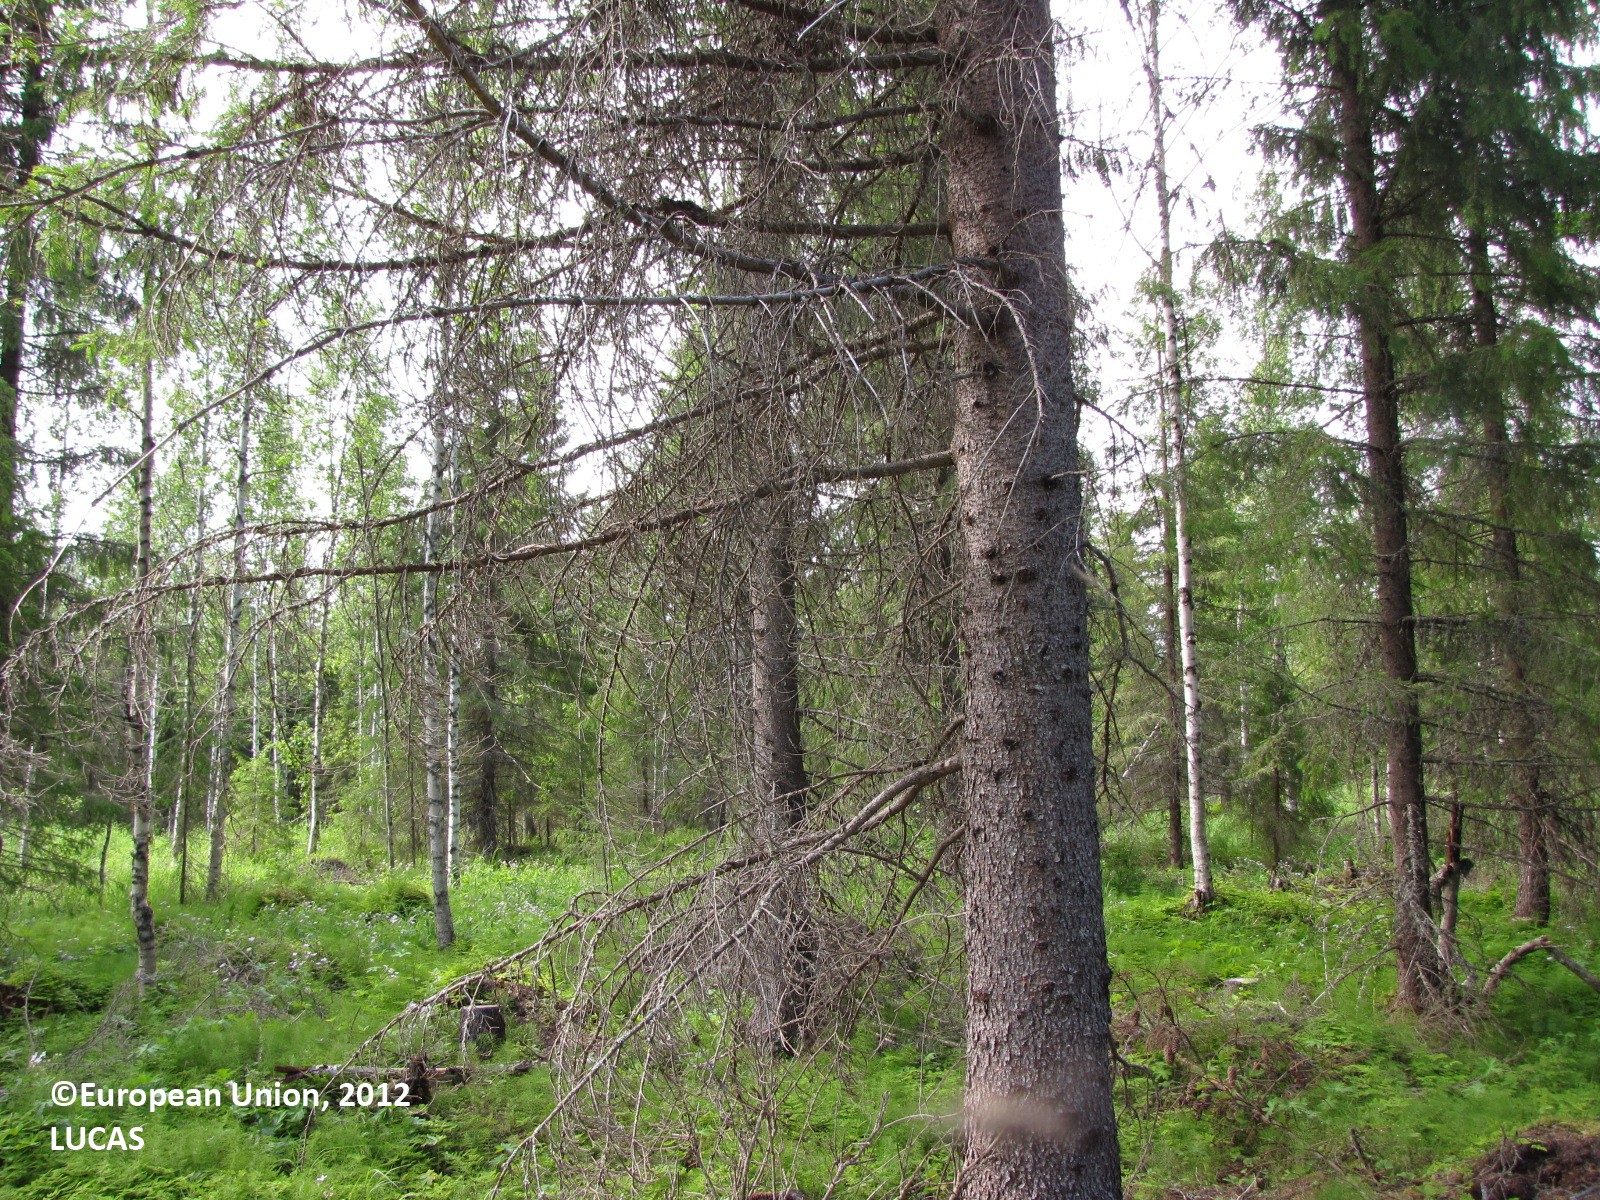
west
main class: Woodland
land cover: Spruce dominated coniferous woodland
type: boreal forest
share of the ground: 50 - 75 %
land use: Forestry
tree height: > 5 m
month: July
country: FI
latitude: 66.3763
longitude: 25.0168
